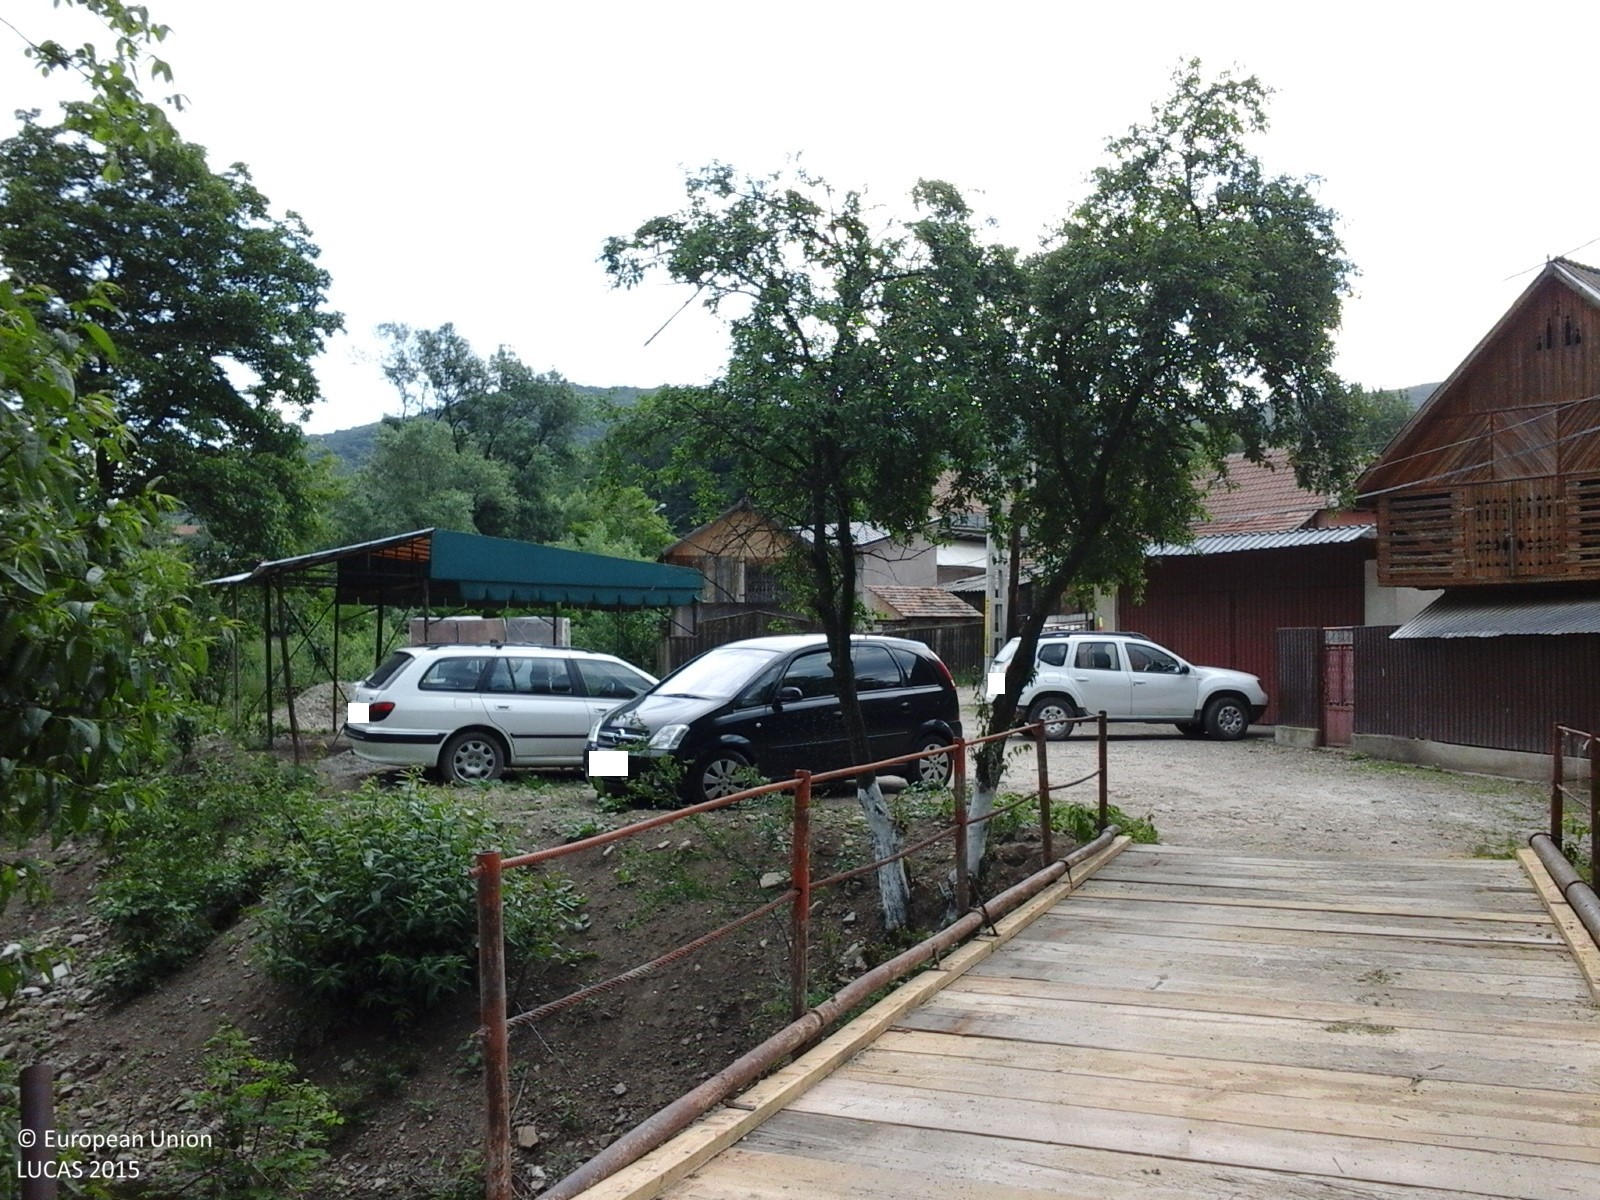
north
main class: Grassland
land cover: Grassland without tree/shrub cover
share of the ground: > 75 %
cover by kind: herbaceous plants 100 %
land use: Residential
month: June
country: RO
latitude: 46.4586
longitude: 26.4736
